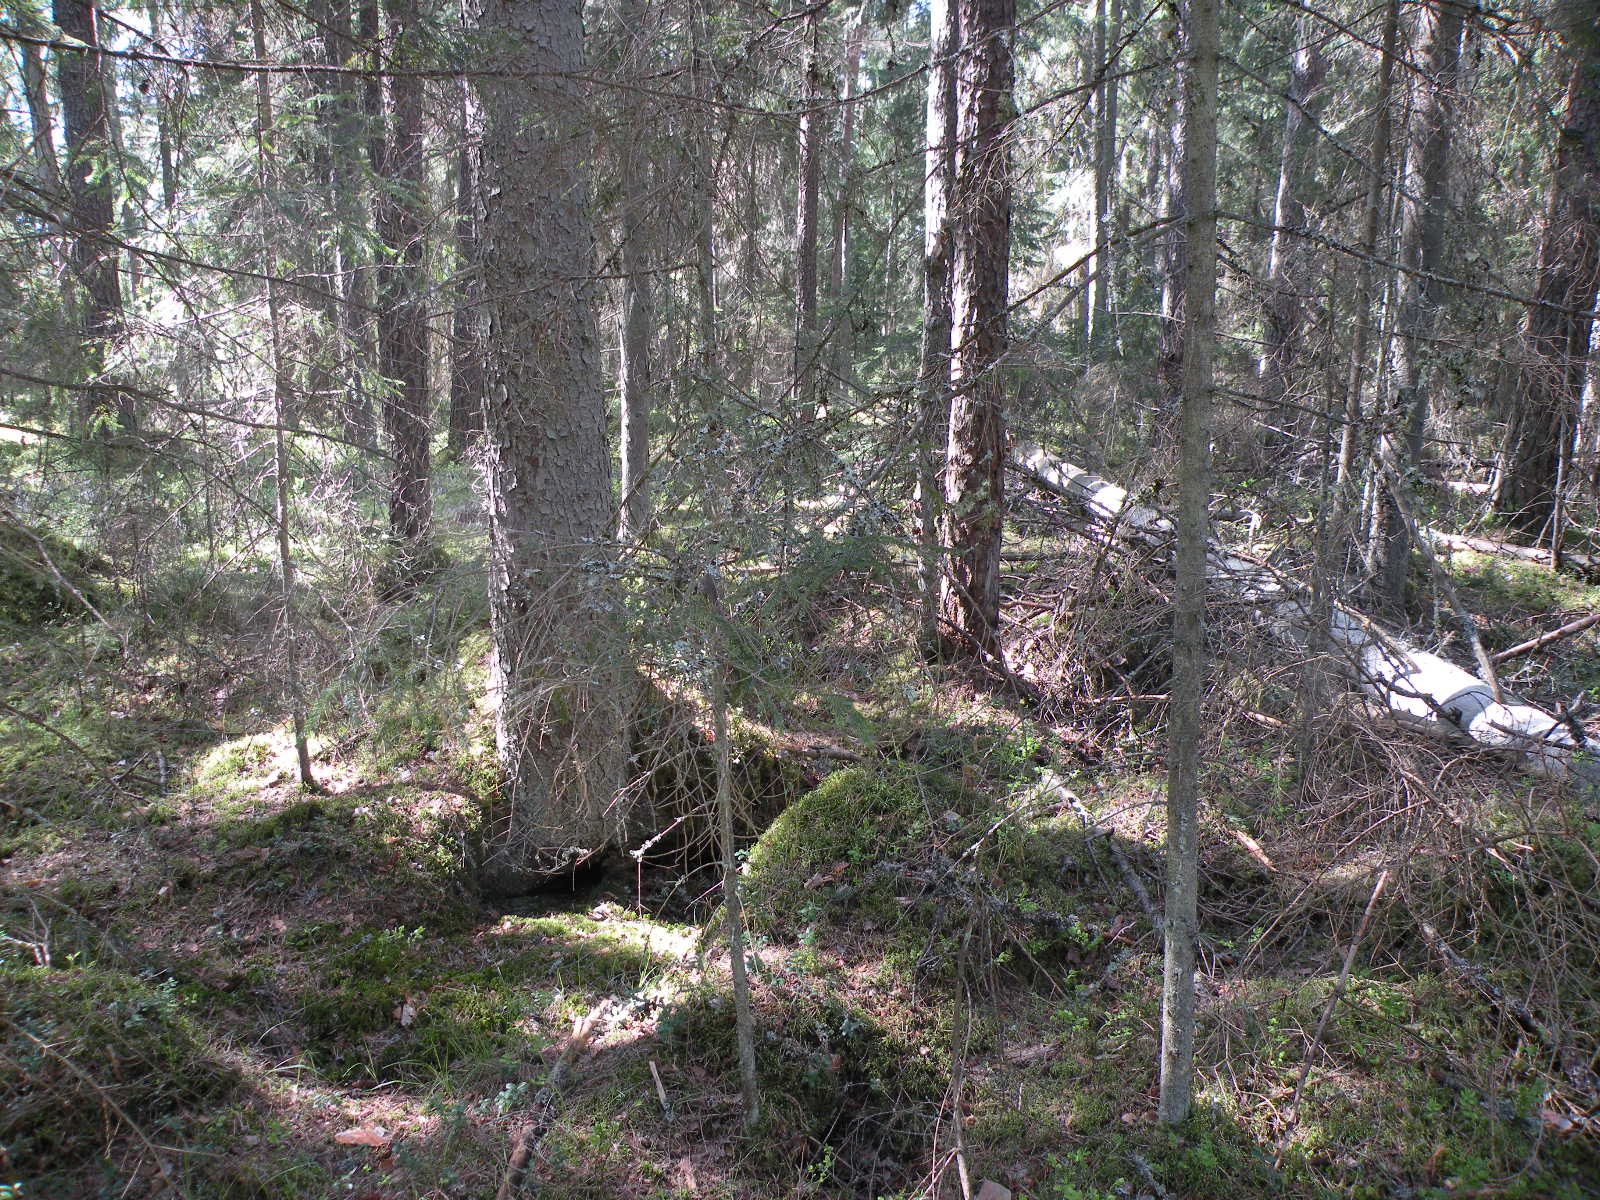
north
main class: Woodland
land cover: Spruce dominated coniferous woodland
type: hemiboreal forest and nemoral coniferous forest and mixed broadleaved-coniferous forest
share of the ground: > 75 %
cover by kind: coniferous forest trees 100 %
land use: Forestry
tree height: > 5 m
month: May
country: LV
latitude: 56.0956
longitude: 26.2656
